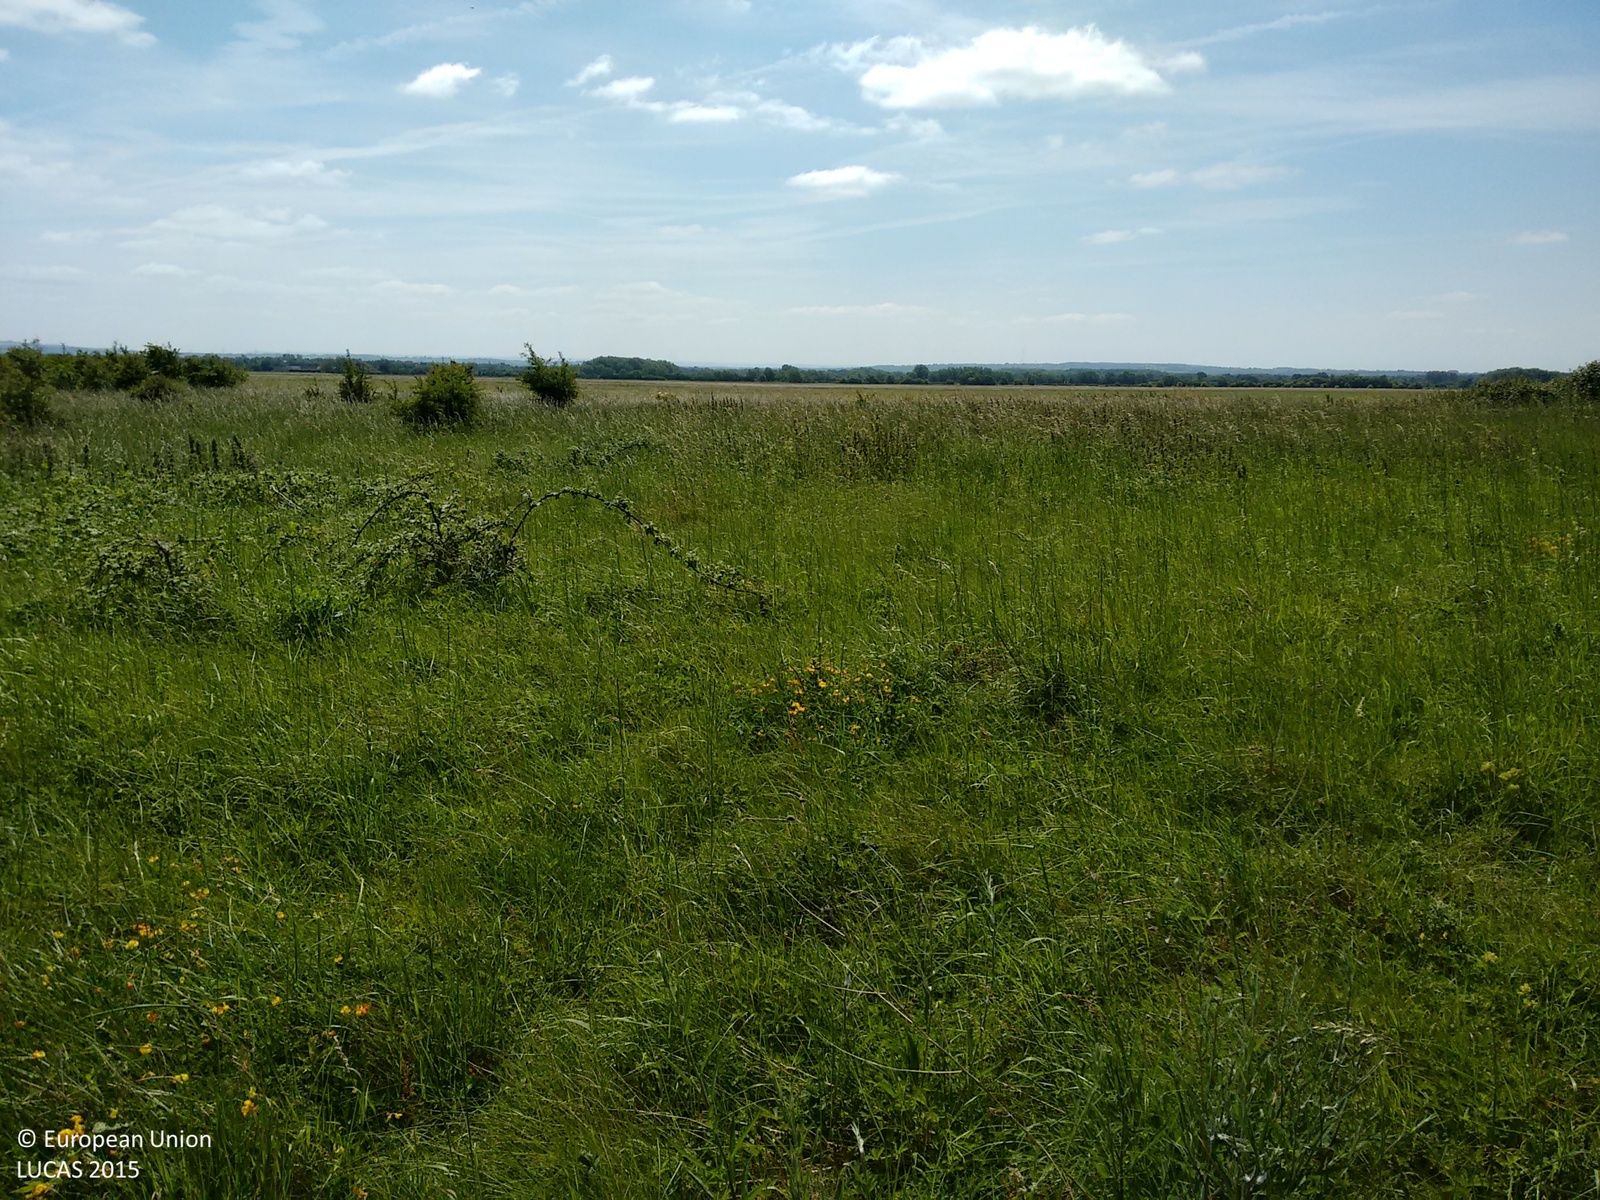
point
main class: Grassland
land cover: Grassland without tree/shrub cover
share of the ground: > 75 %
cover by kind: herbaceous plants 100 %
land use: Air transport
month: June
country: GB
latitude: 51.8801
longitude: -1.2185
